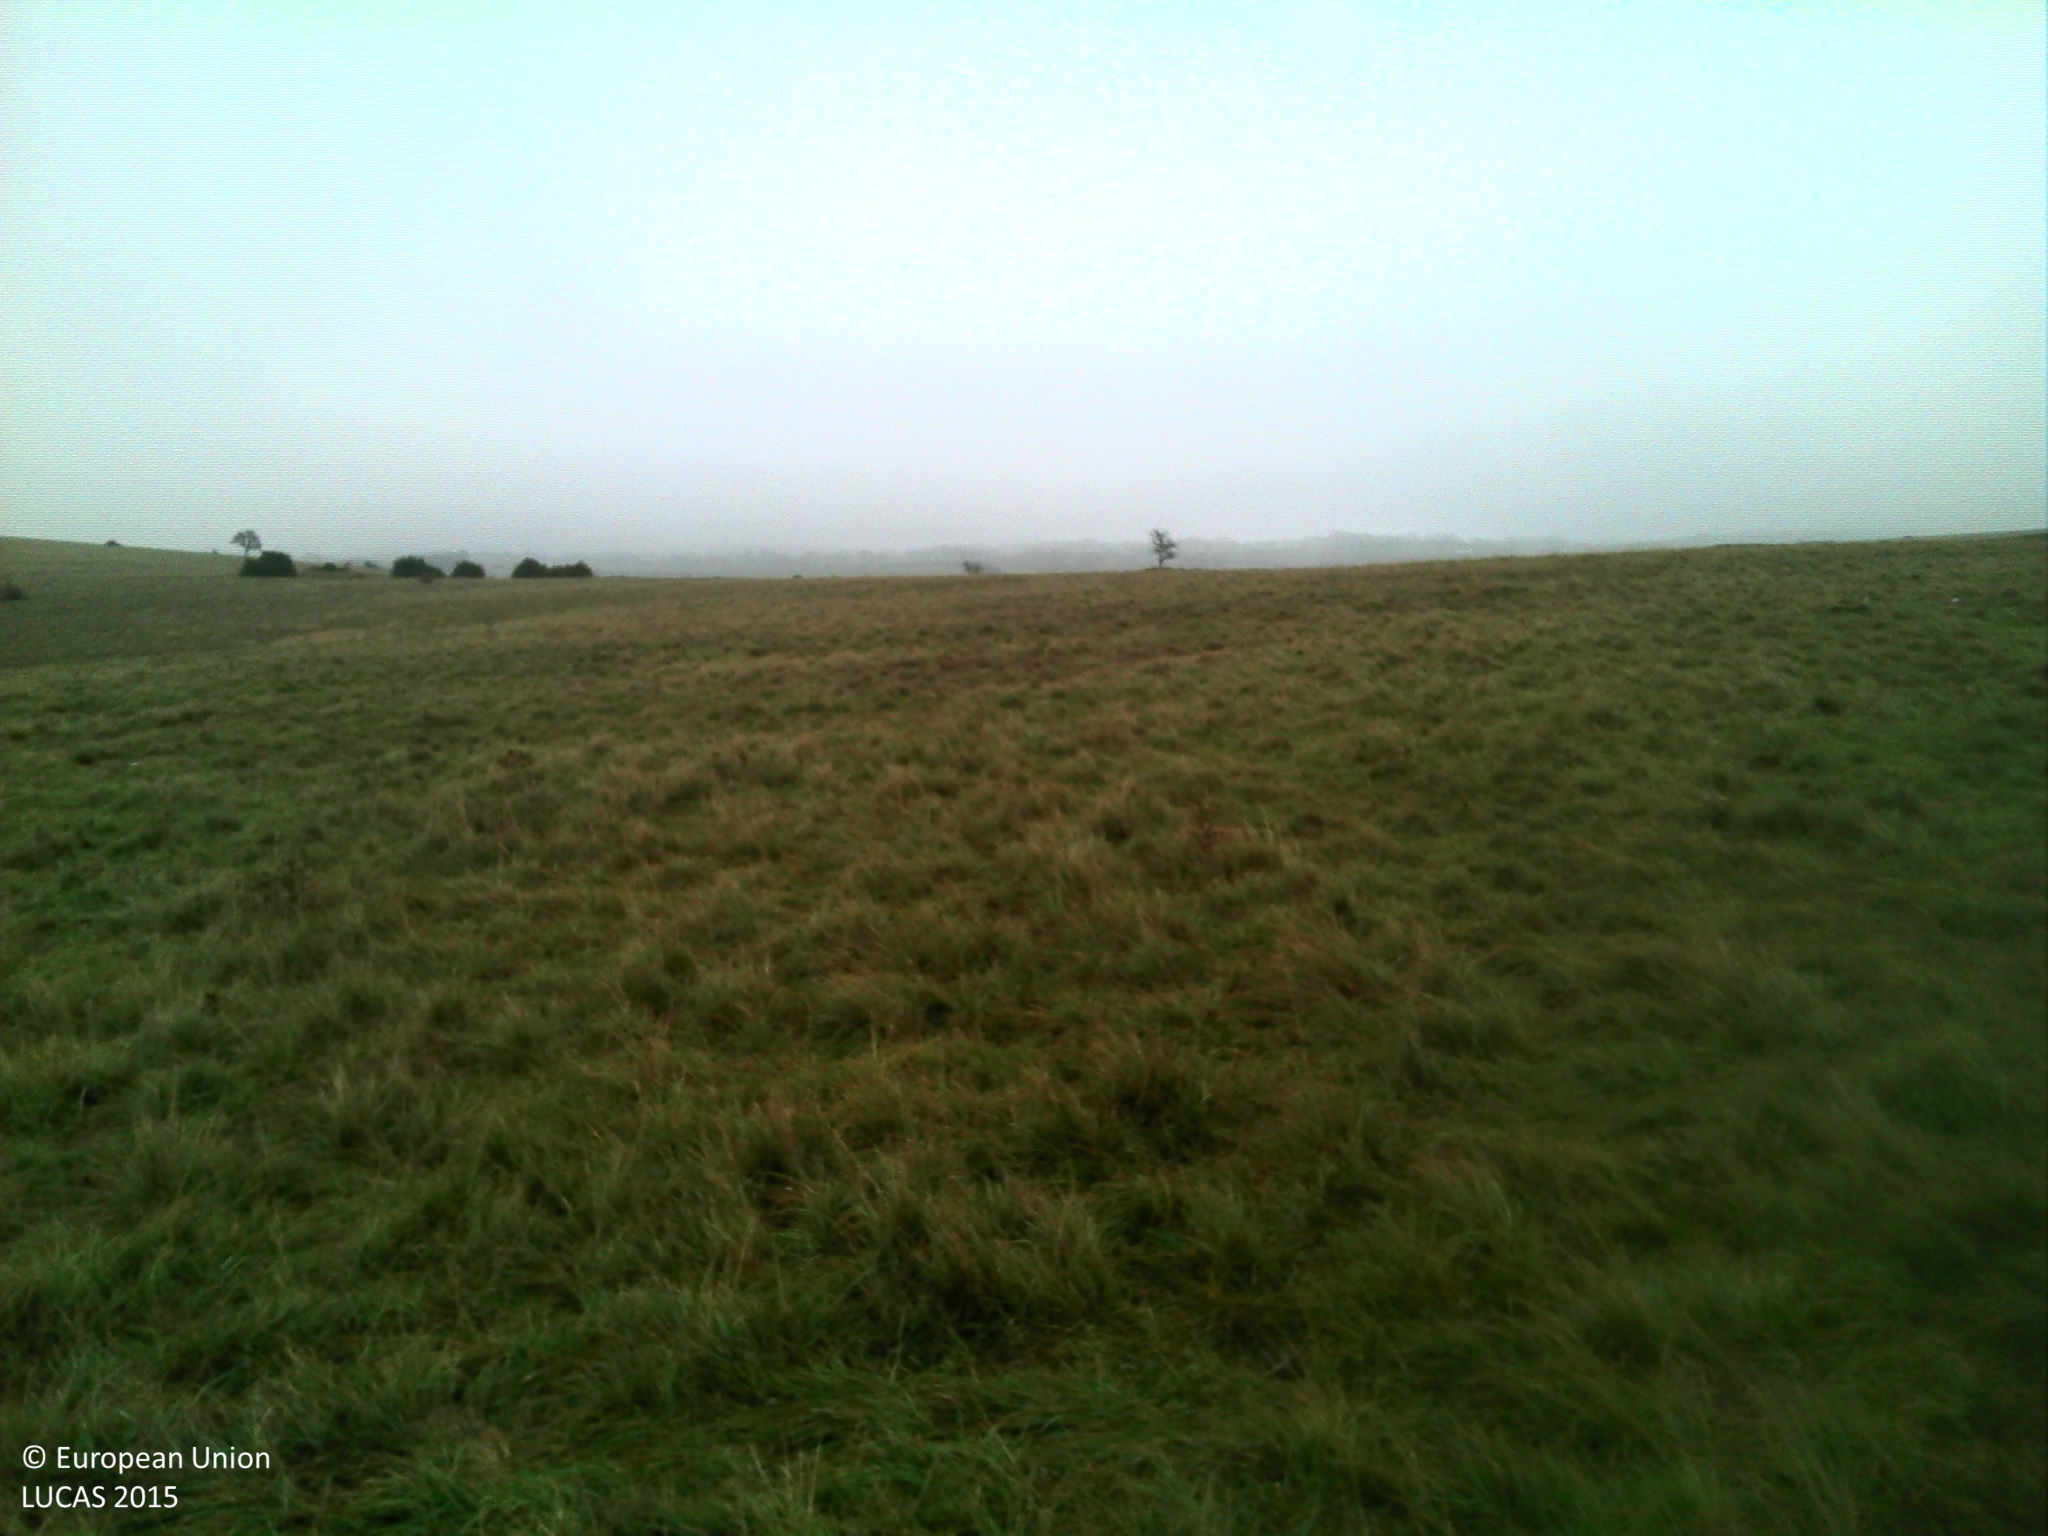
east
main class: Grassland
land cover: Grassland without tree/shrub cover
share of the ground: > 75 %
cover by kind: herbaceous plants 100 %
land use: Agriculture (excluding fallow land and kitchen gardens)
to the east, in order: Grassland without tree/shrub cover
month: November
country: FR
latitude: 44.0290
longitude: 3.0815
